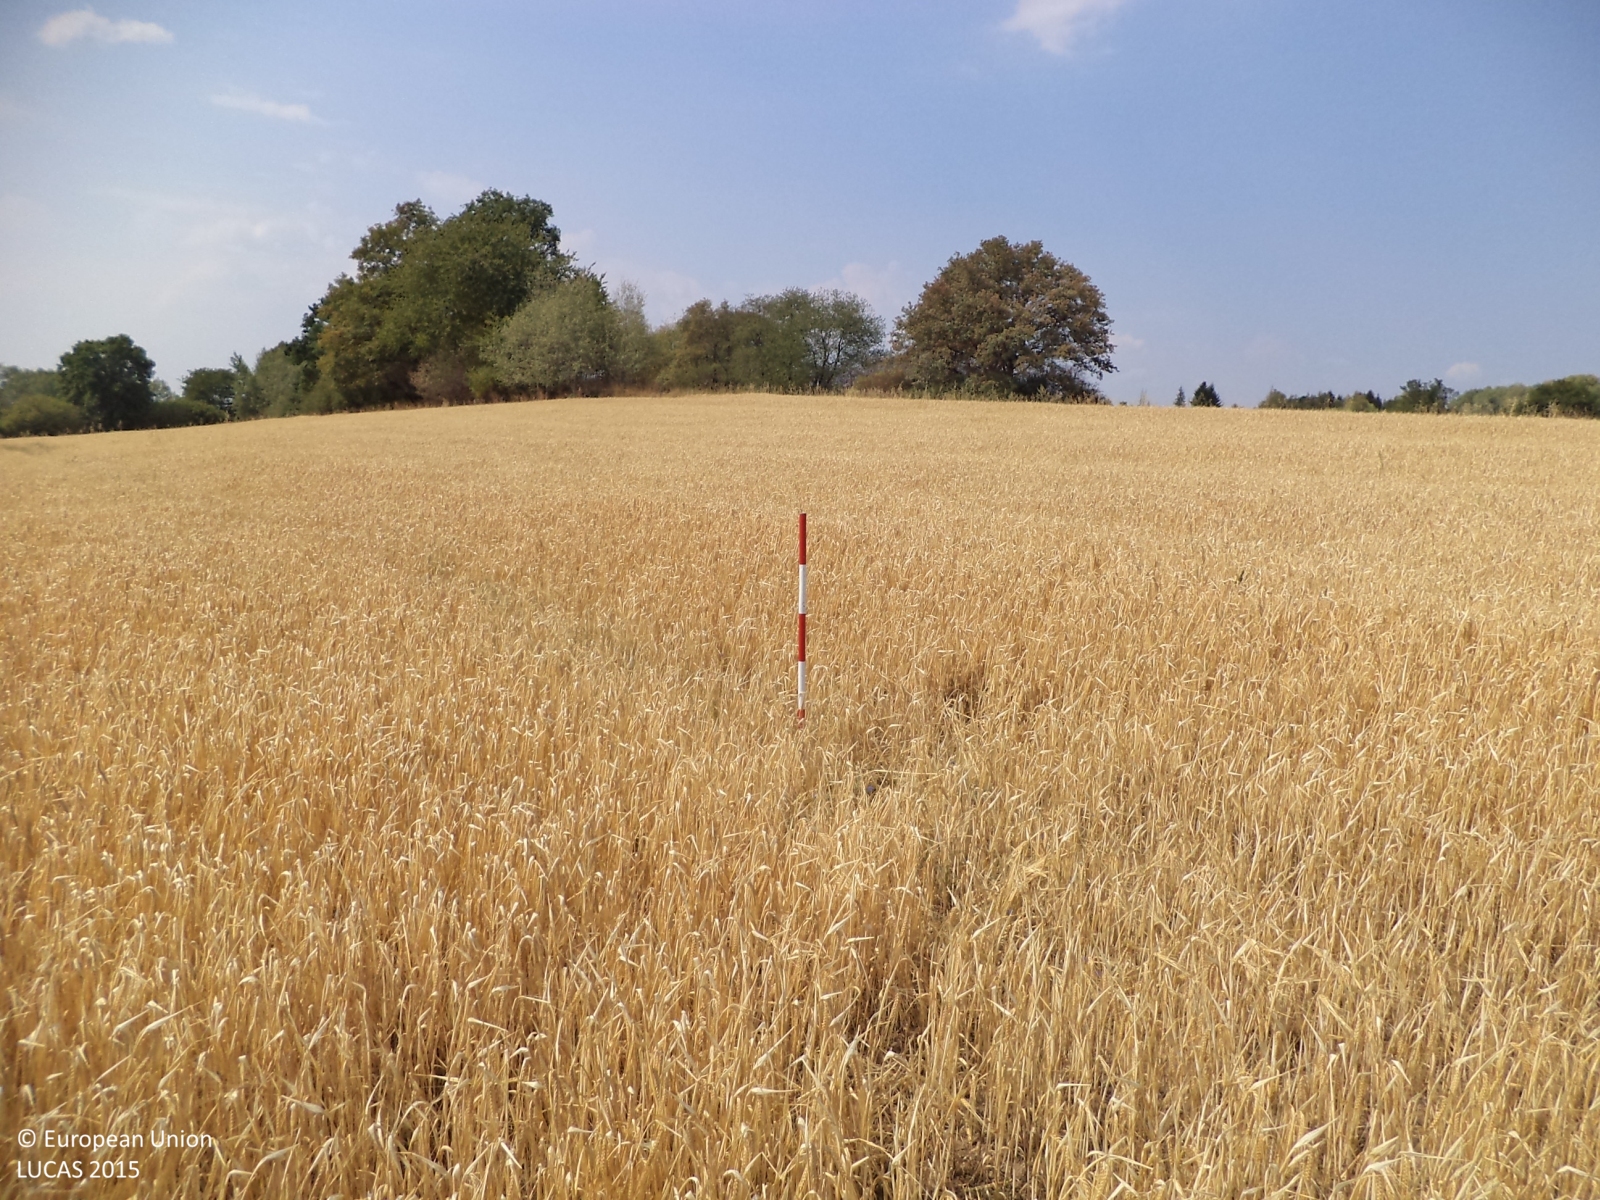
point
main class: Cropland
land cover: Barley
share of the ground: > 75 %
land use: Agriculture (excluding fallow land and kitchen gardens)
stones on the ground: < 10 %
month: August
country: CZ
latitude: 49.5037
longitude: 14.4340
